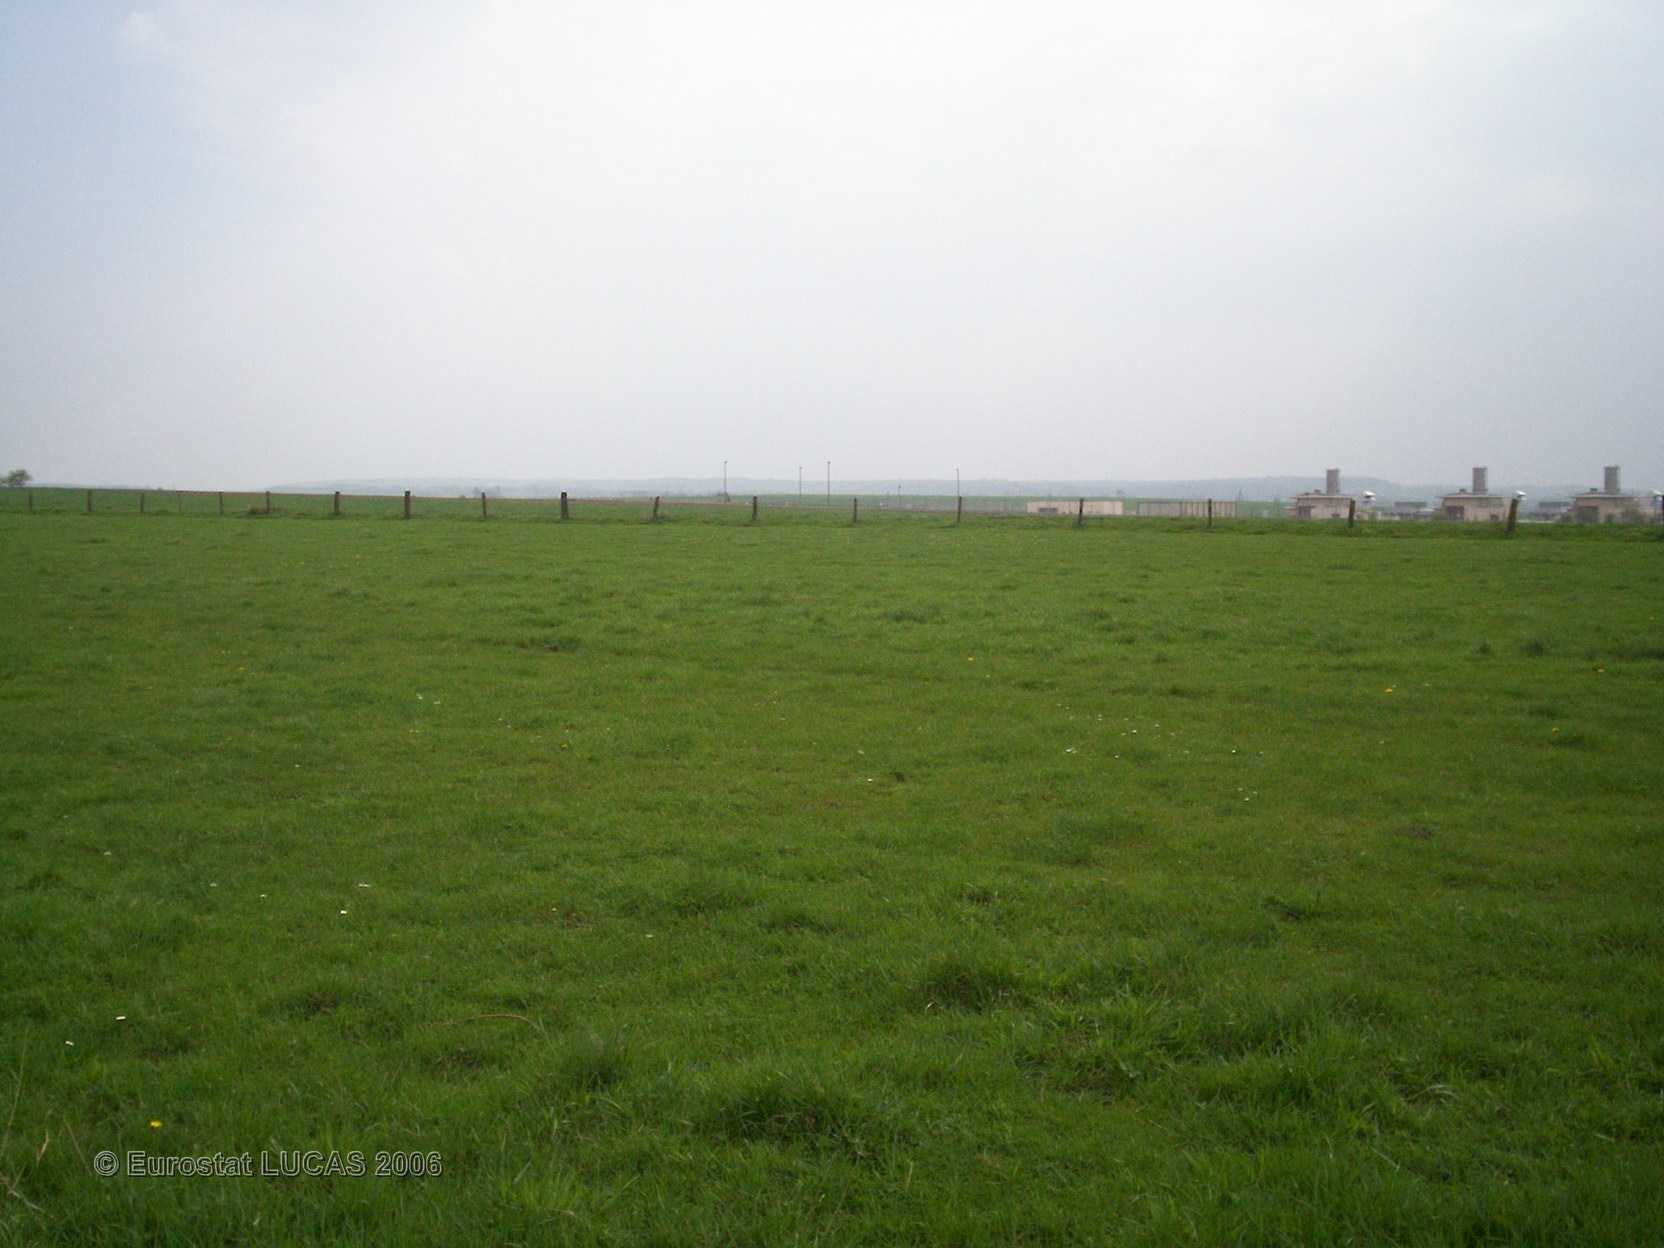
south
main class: Grassland
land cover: Grassland without tree/shrub cover
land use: Agriculture (excluding fallow land and kitchen gardens)
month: April
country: FR
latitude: 48.3290
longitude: 5.9401
